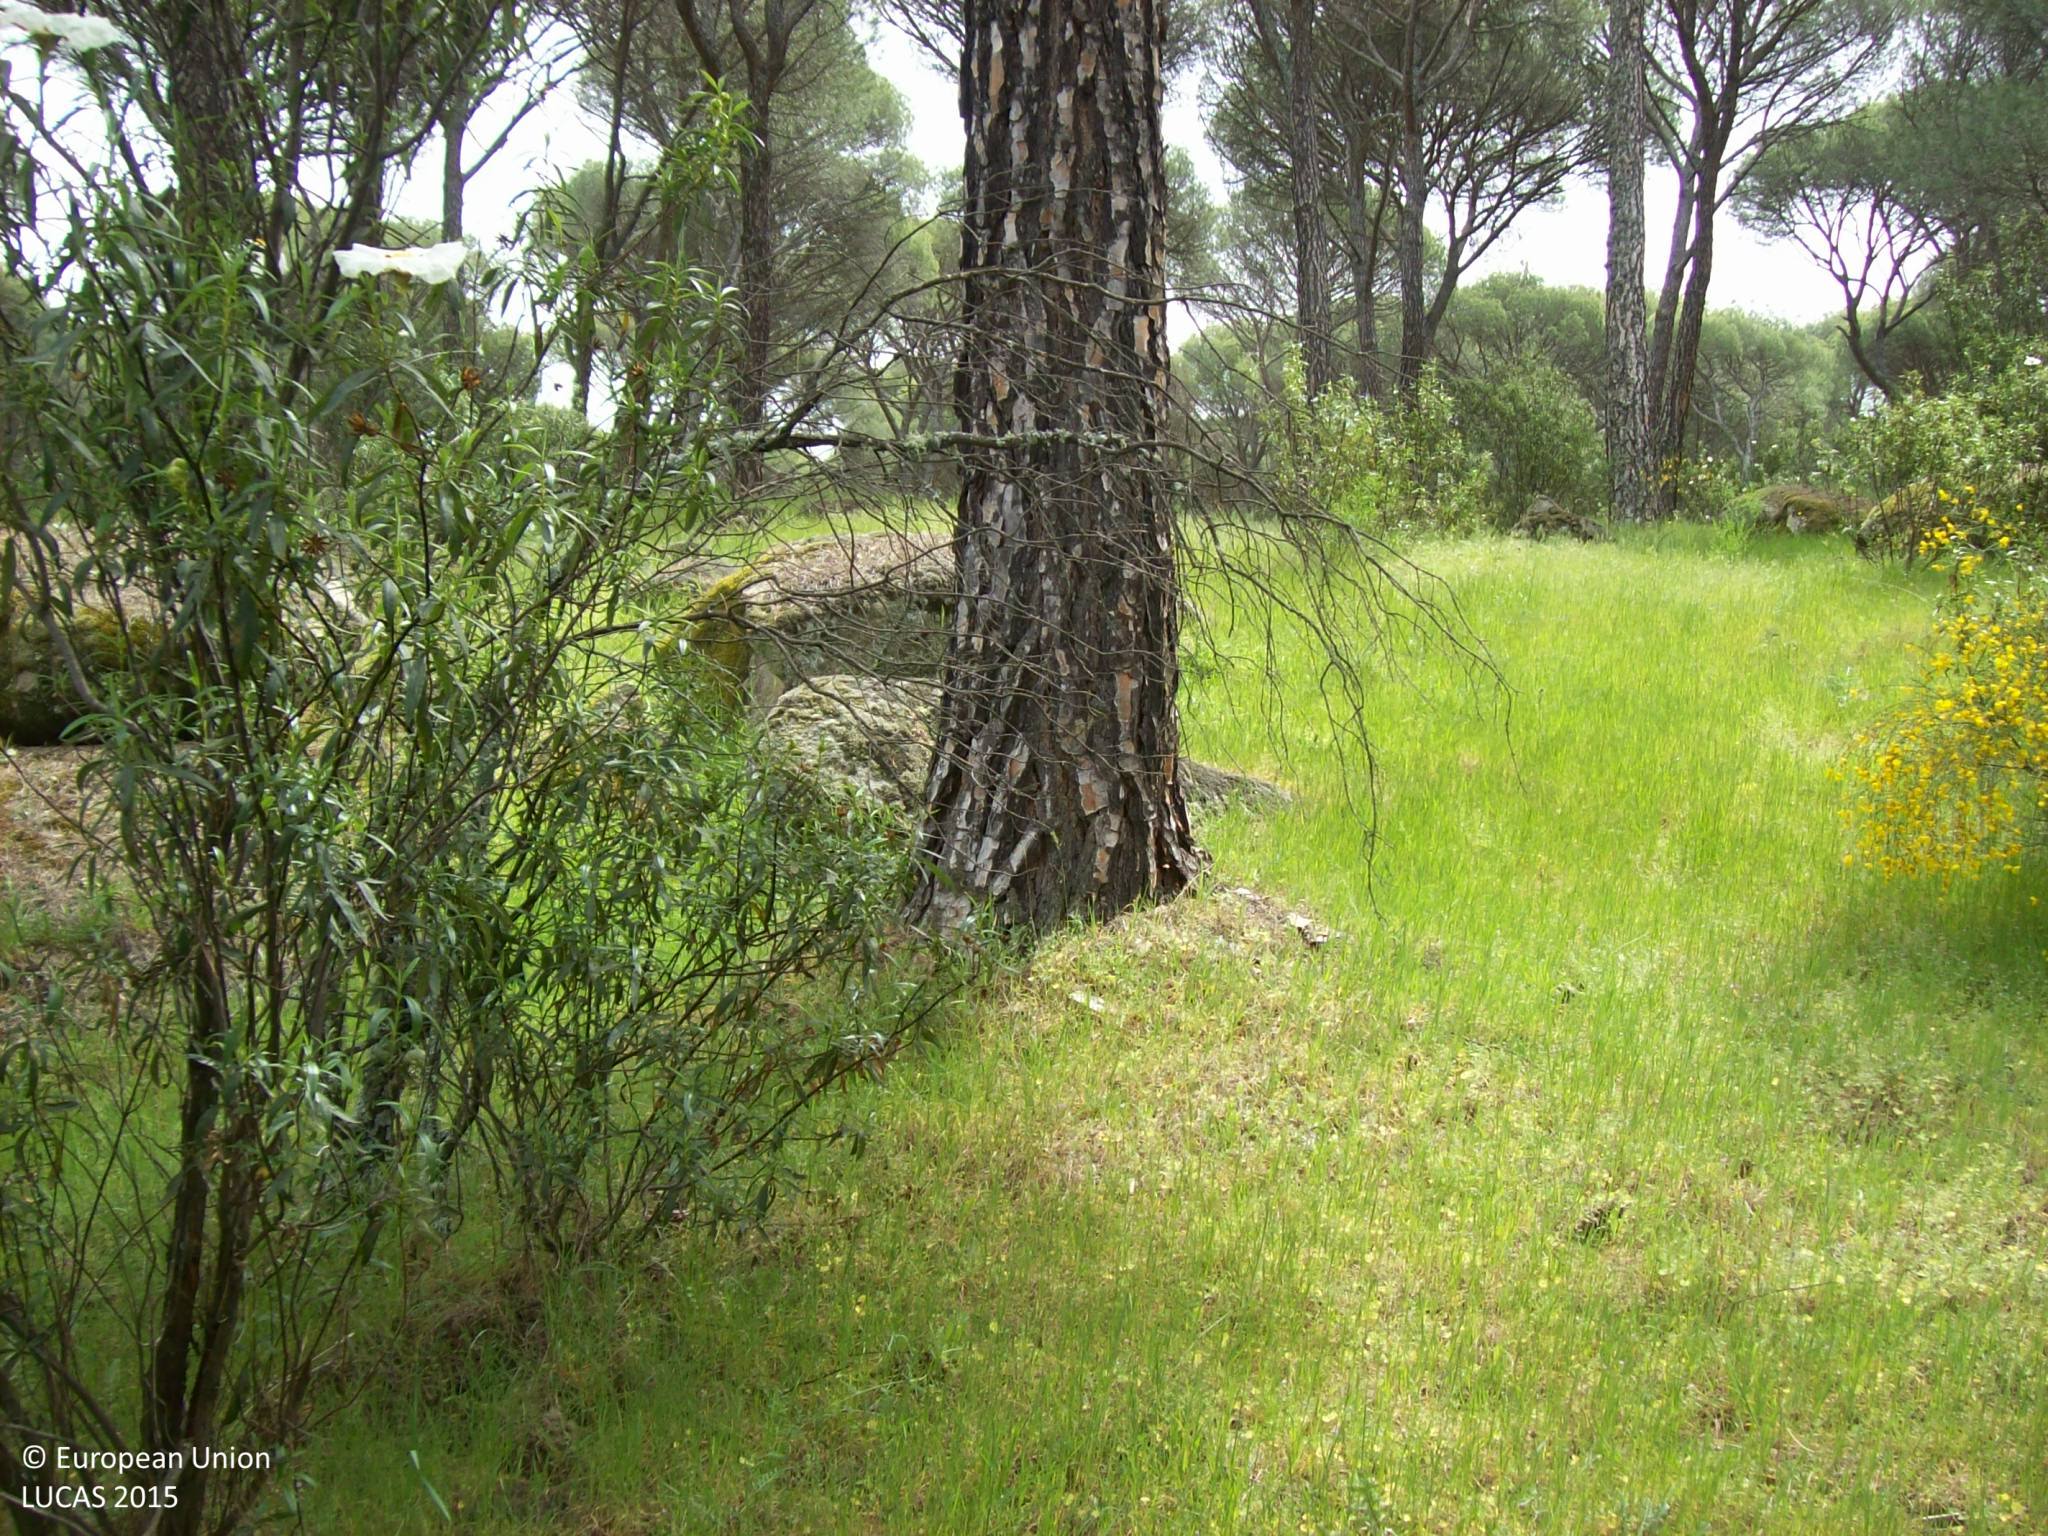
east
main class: Woodland
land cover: Pine dominated coniferous woodland
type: coniferous forest of the mediterranean region
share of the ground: > 75 %
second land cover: Grassland without tree/shrub cover
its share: > 75 %
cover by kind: coniferous forest trees 70 %, herbaceous plants 20 %, shrubs 5 %, consolidated bare surface 5 %
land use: Forestry
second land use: Agriculture (excluding fallow land and kitchen gardens)
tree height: > 5 m
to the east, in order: Pine dominated coniferous woodland; Grassland without tree/shrub cover
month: April
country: ES
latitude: 40.4643
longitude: -4.4009
